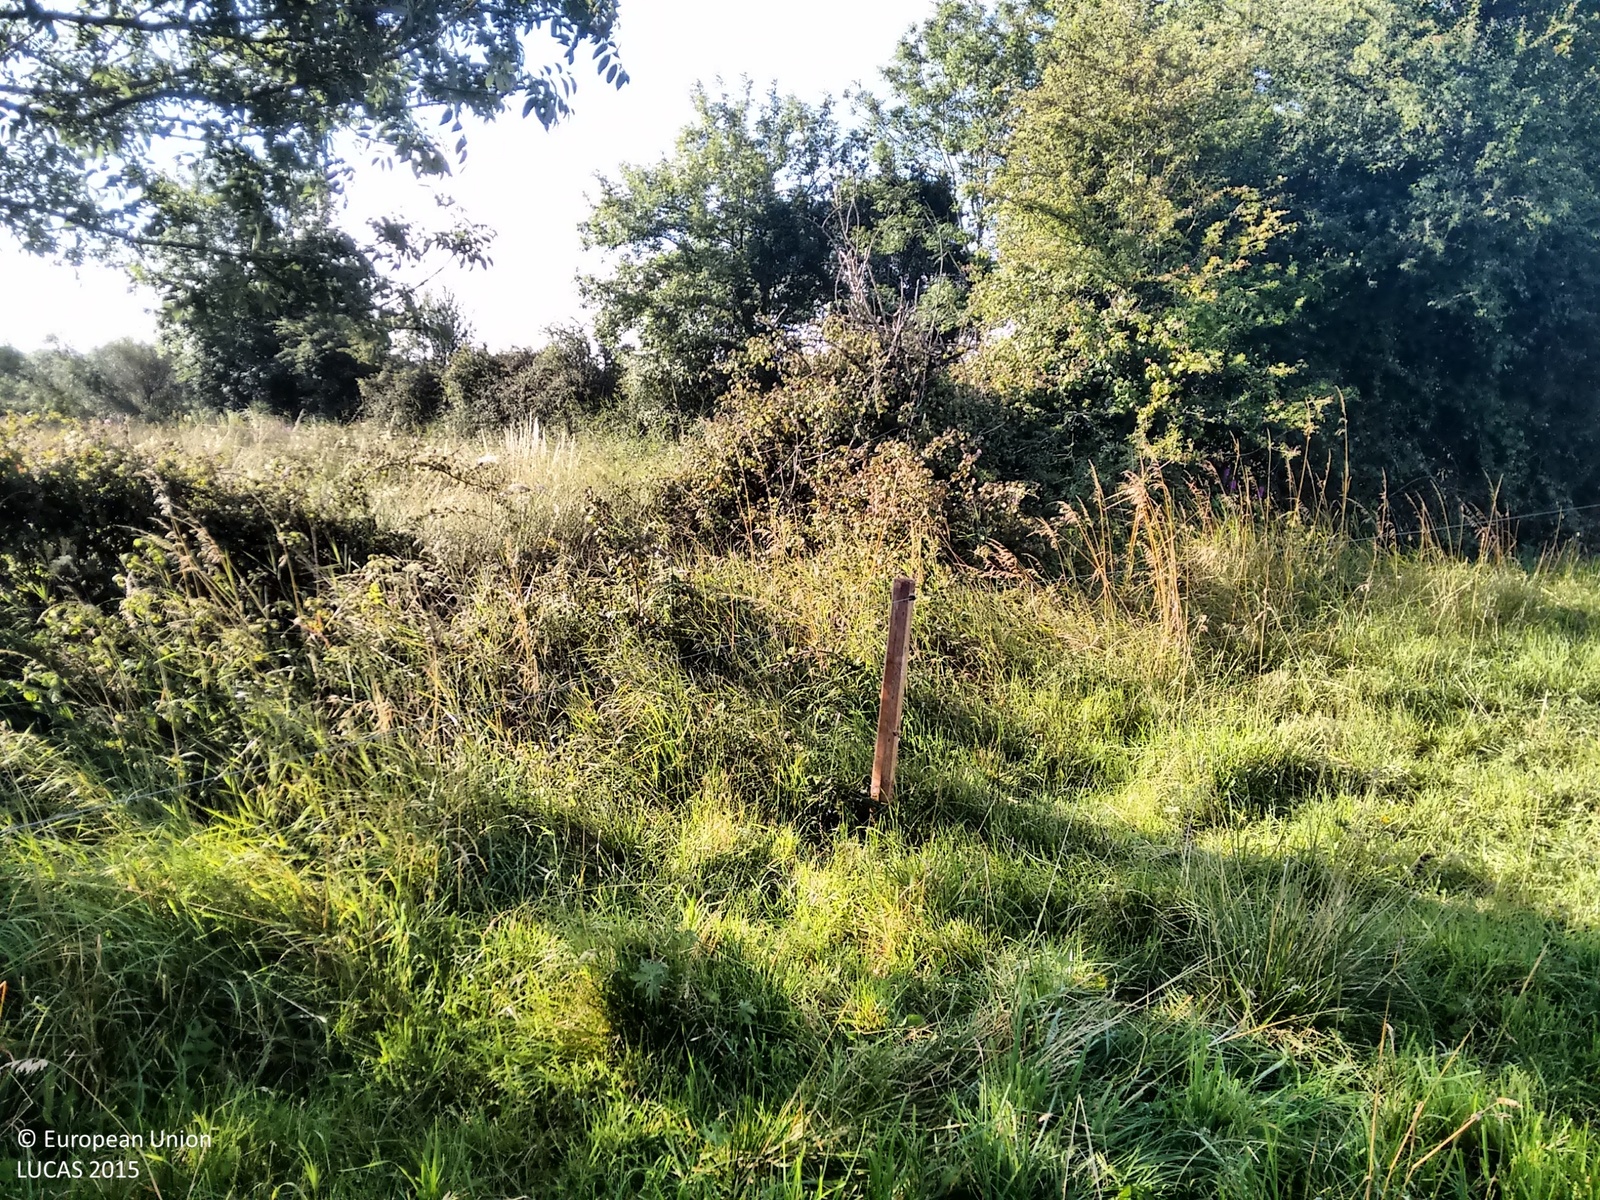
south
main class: Grassland
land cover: Grassland without tree/shrub cover
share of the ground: > 75 %
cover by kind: herbaceous plants 100 %
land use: Agriculture (excluding fallow land and kitchen gardens)
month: August
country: IE
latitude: 52.5291
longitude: -8.2723
